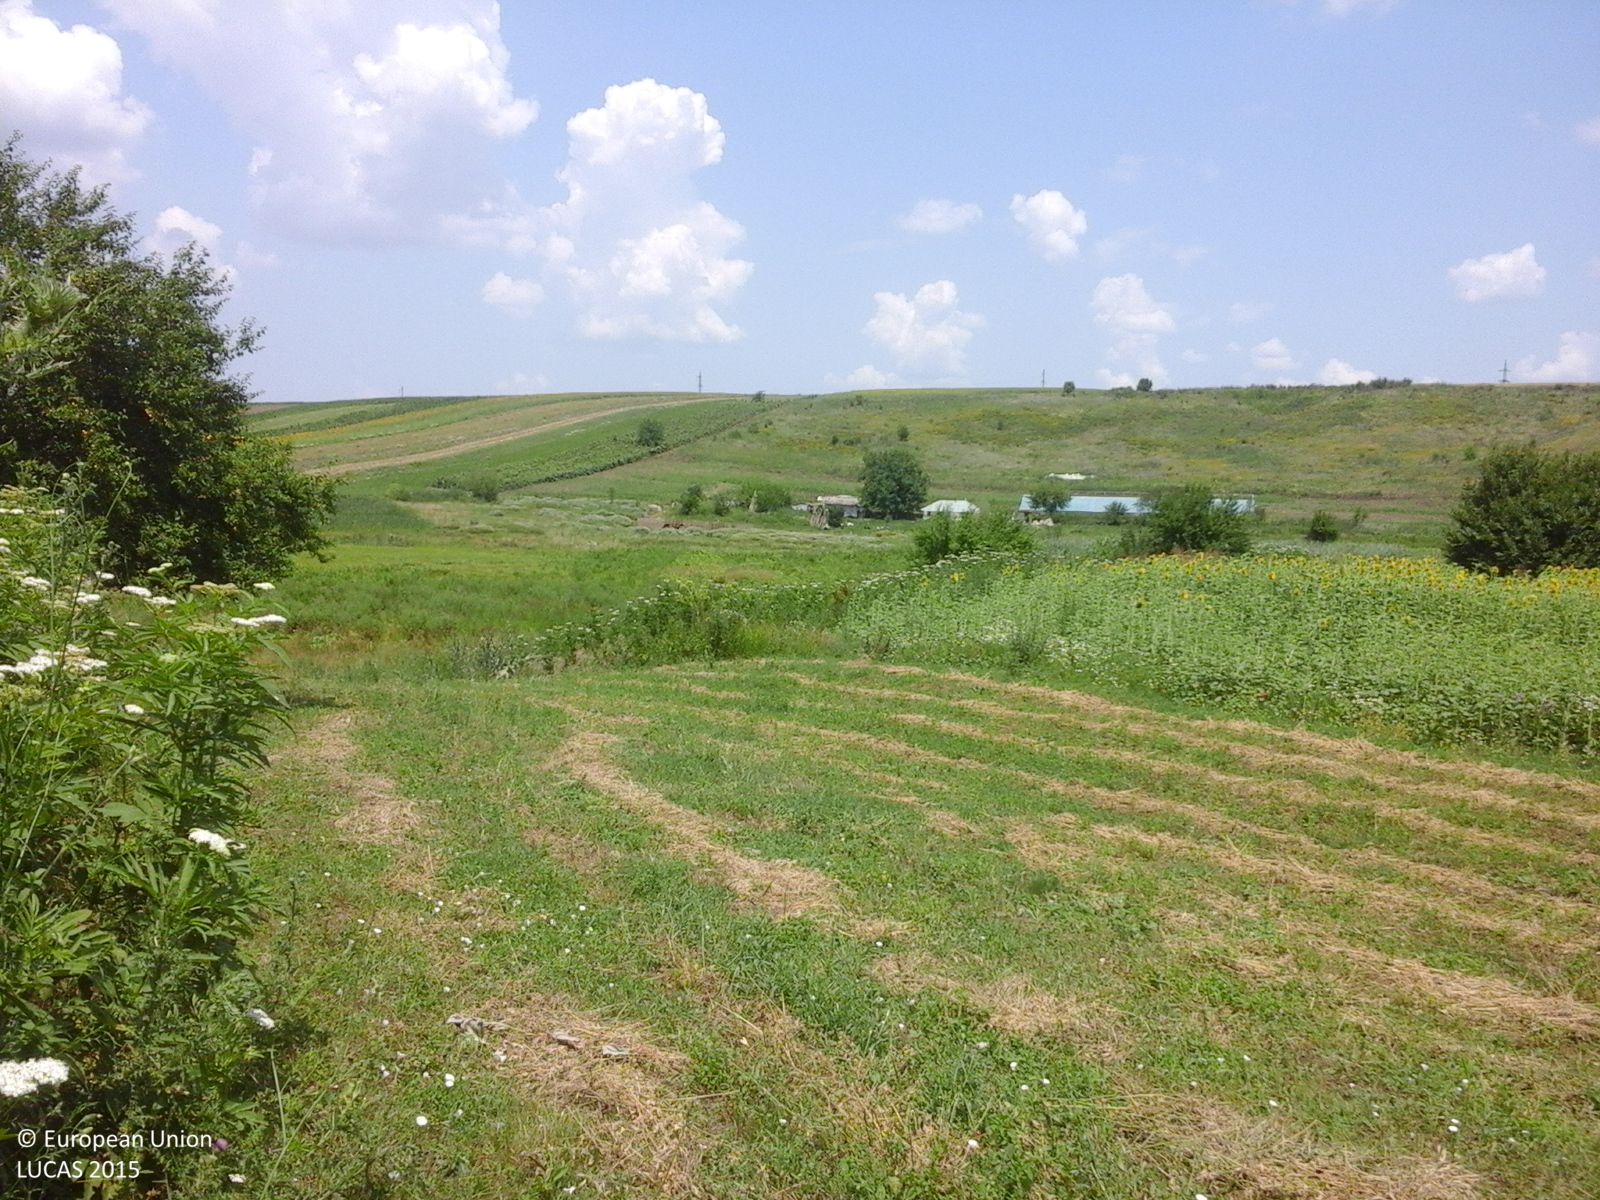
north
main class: Cropland
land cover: Lucerne
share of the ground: > 75 %
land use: Agriculture (excluding fallow land and kitchen gardens)
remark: Harvested field
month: July
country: RO
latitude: 44.1438
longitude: 26.4752
